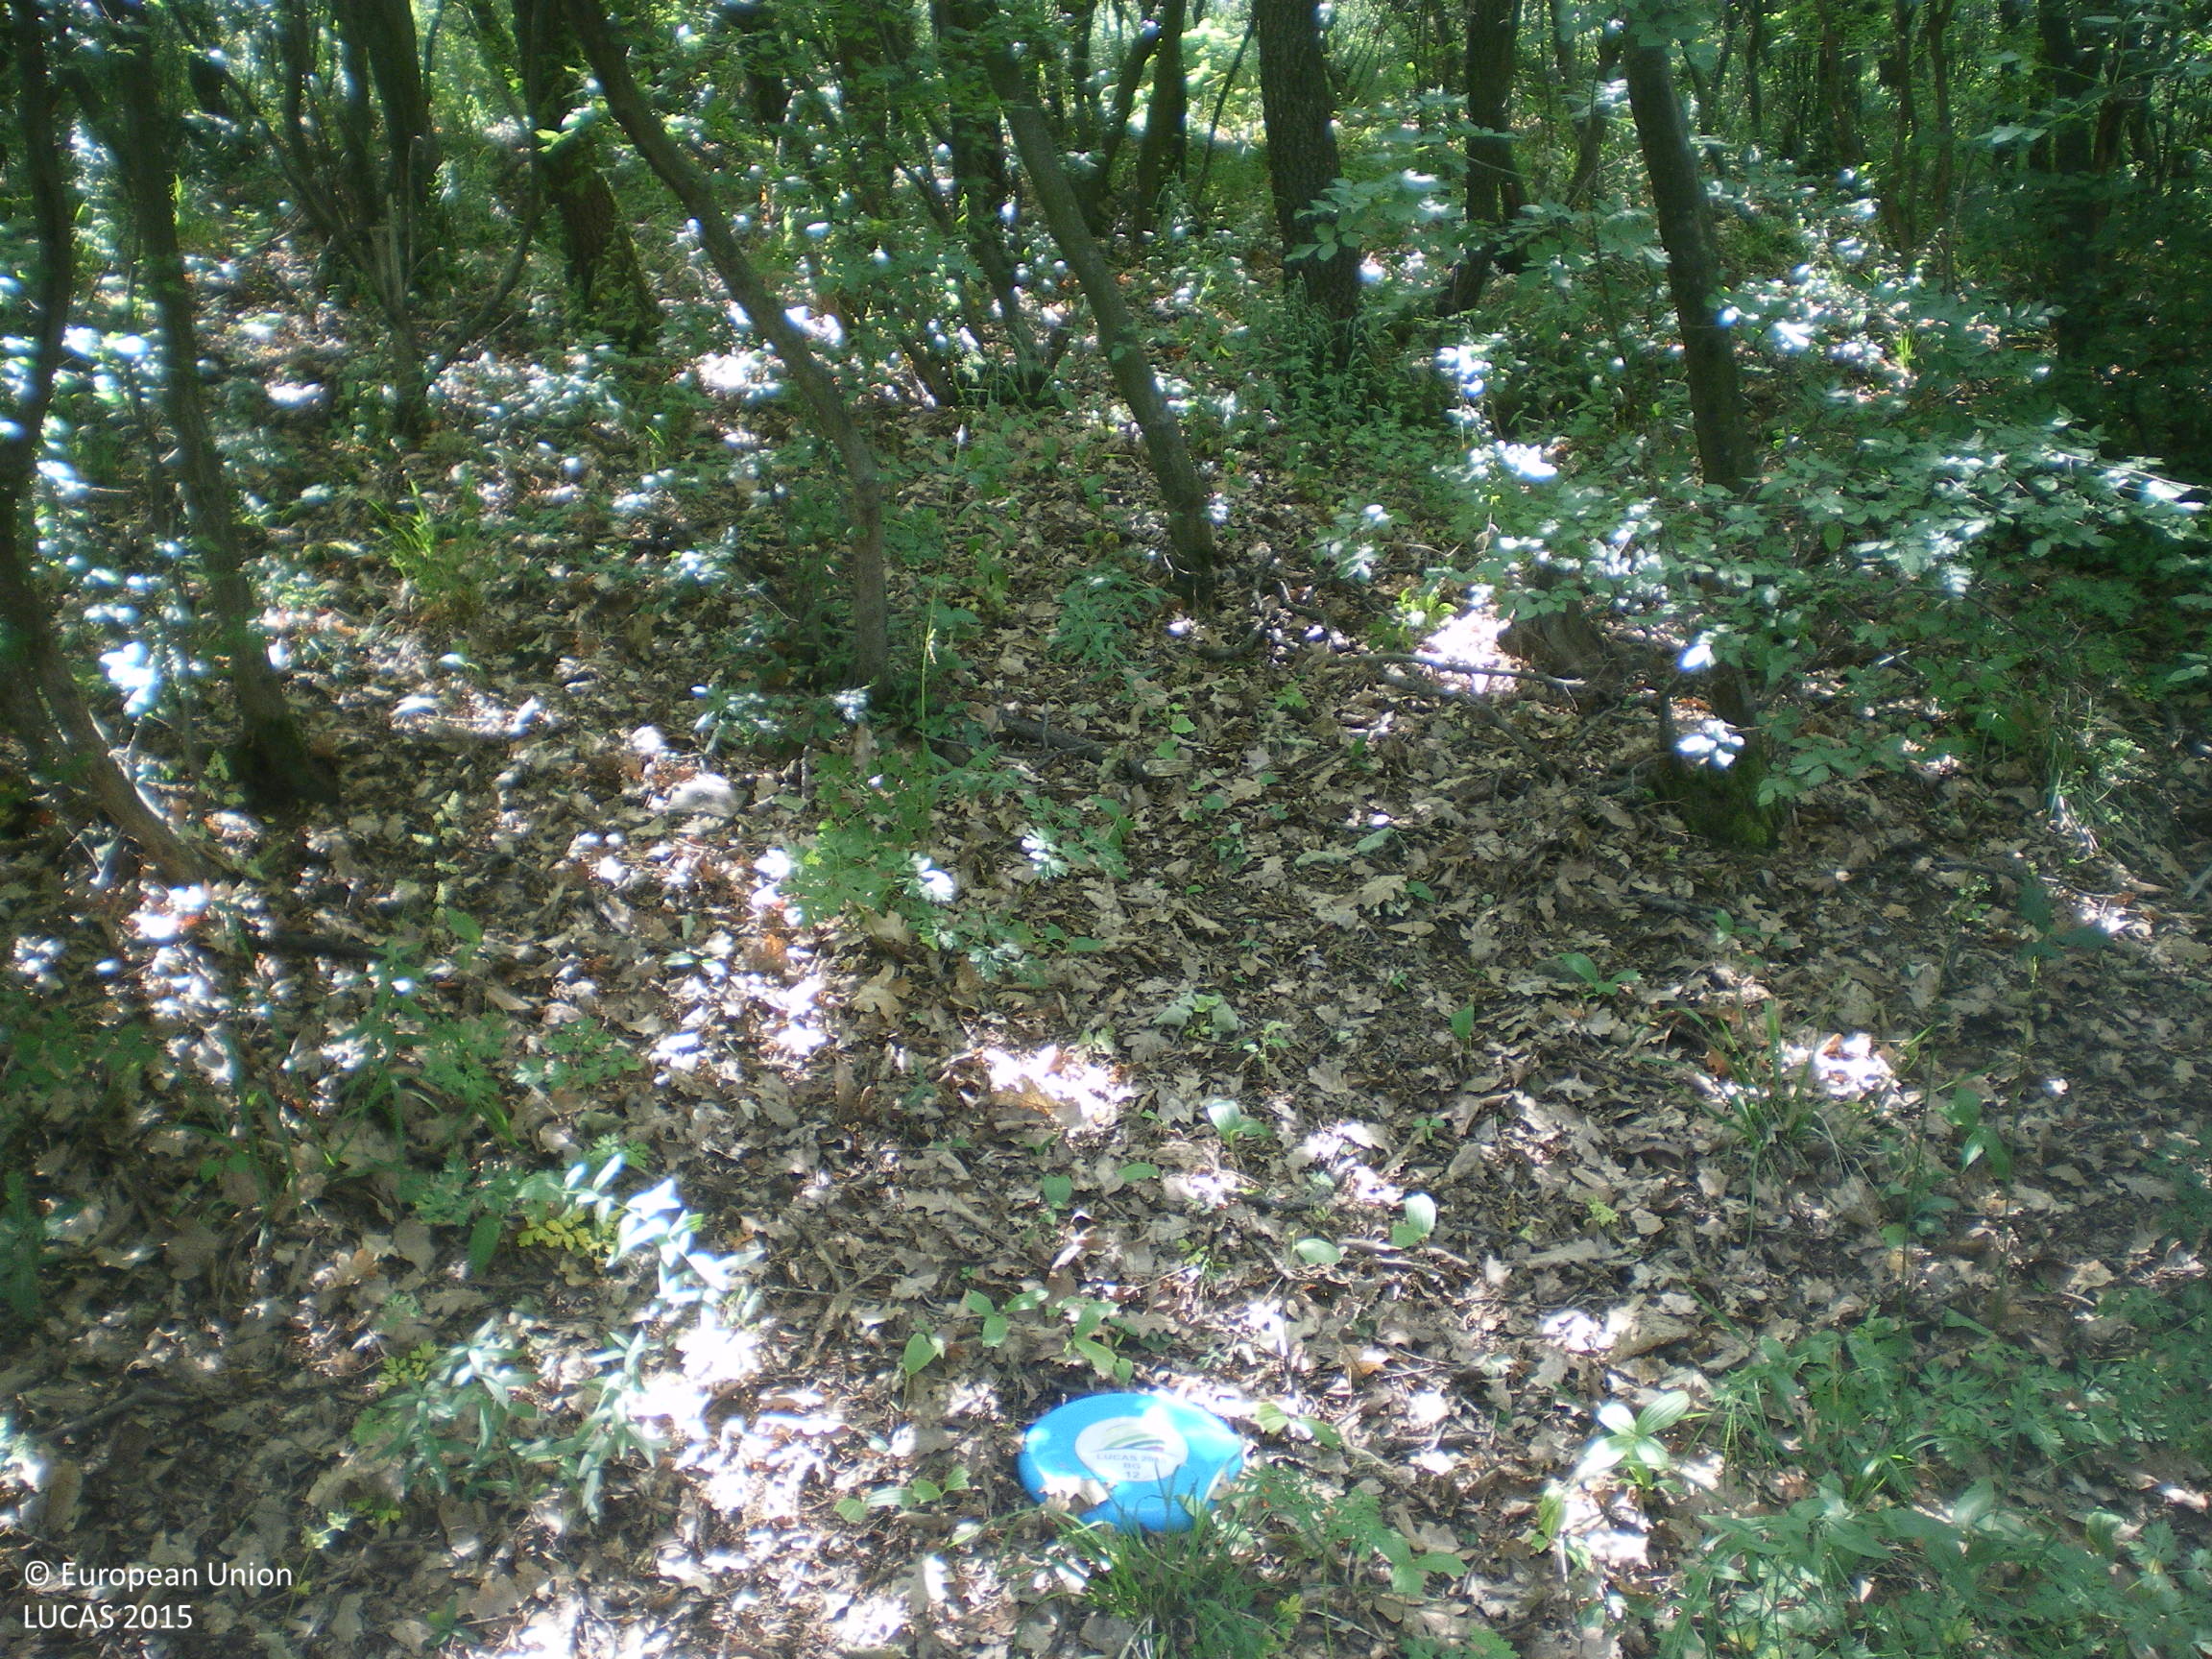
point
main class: Woodland
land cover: Broadleaved woodland
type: mesophytic deciduous forest
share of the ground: > 75 %
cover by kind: broadleaved forest trees 80 %, shrubs 15 %, herbaceous plants 5 %
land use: Forestry
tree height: > 5 m
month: June
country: BG
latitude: 42.3976
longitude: 25.5597
